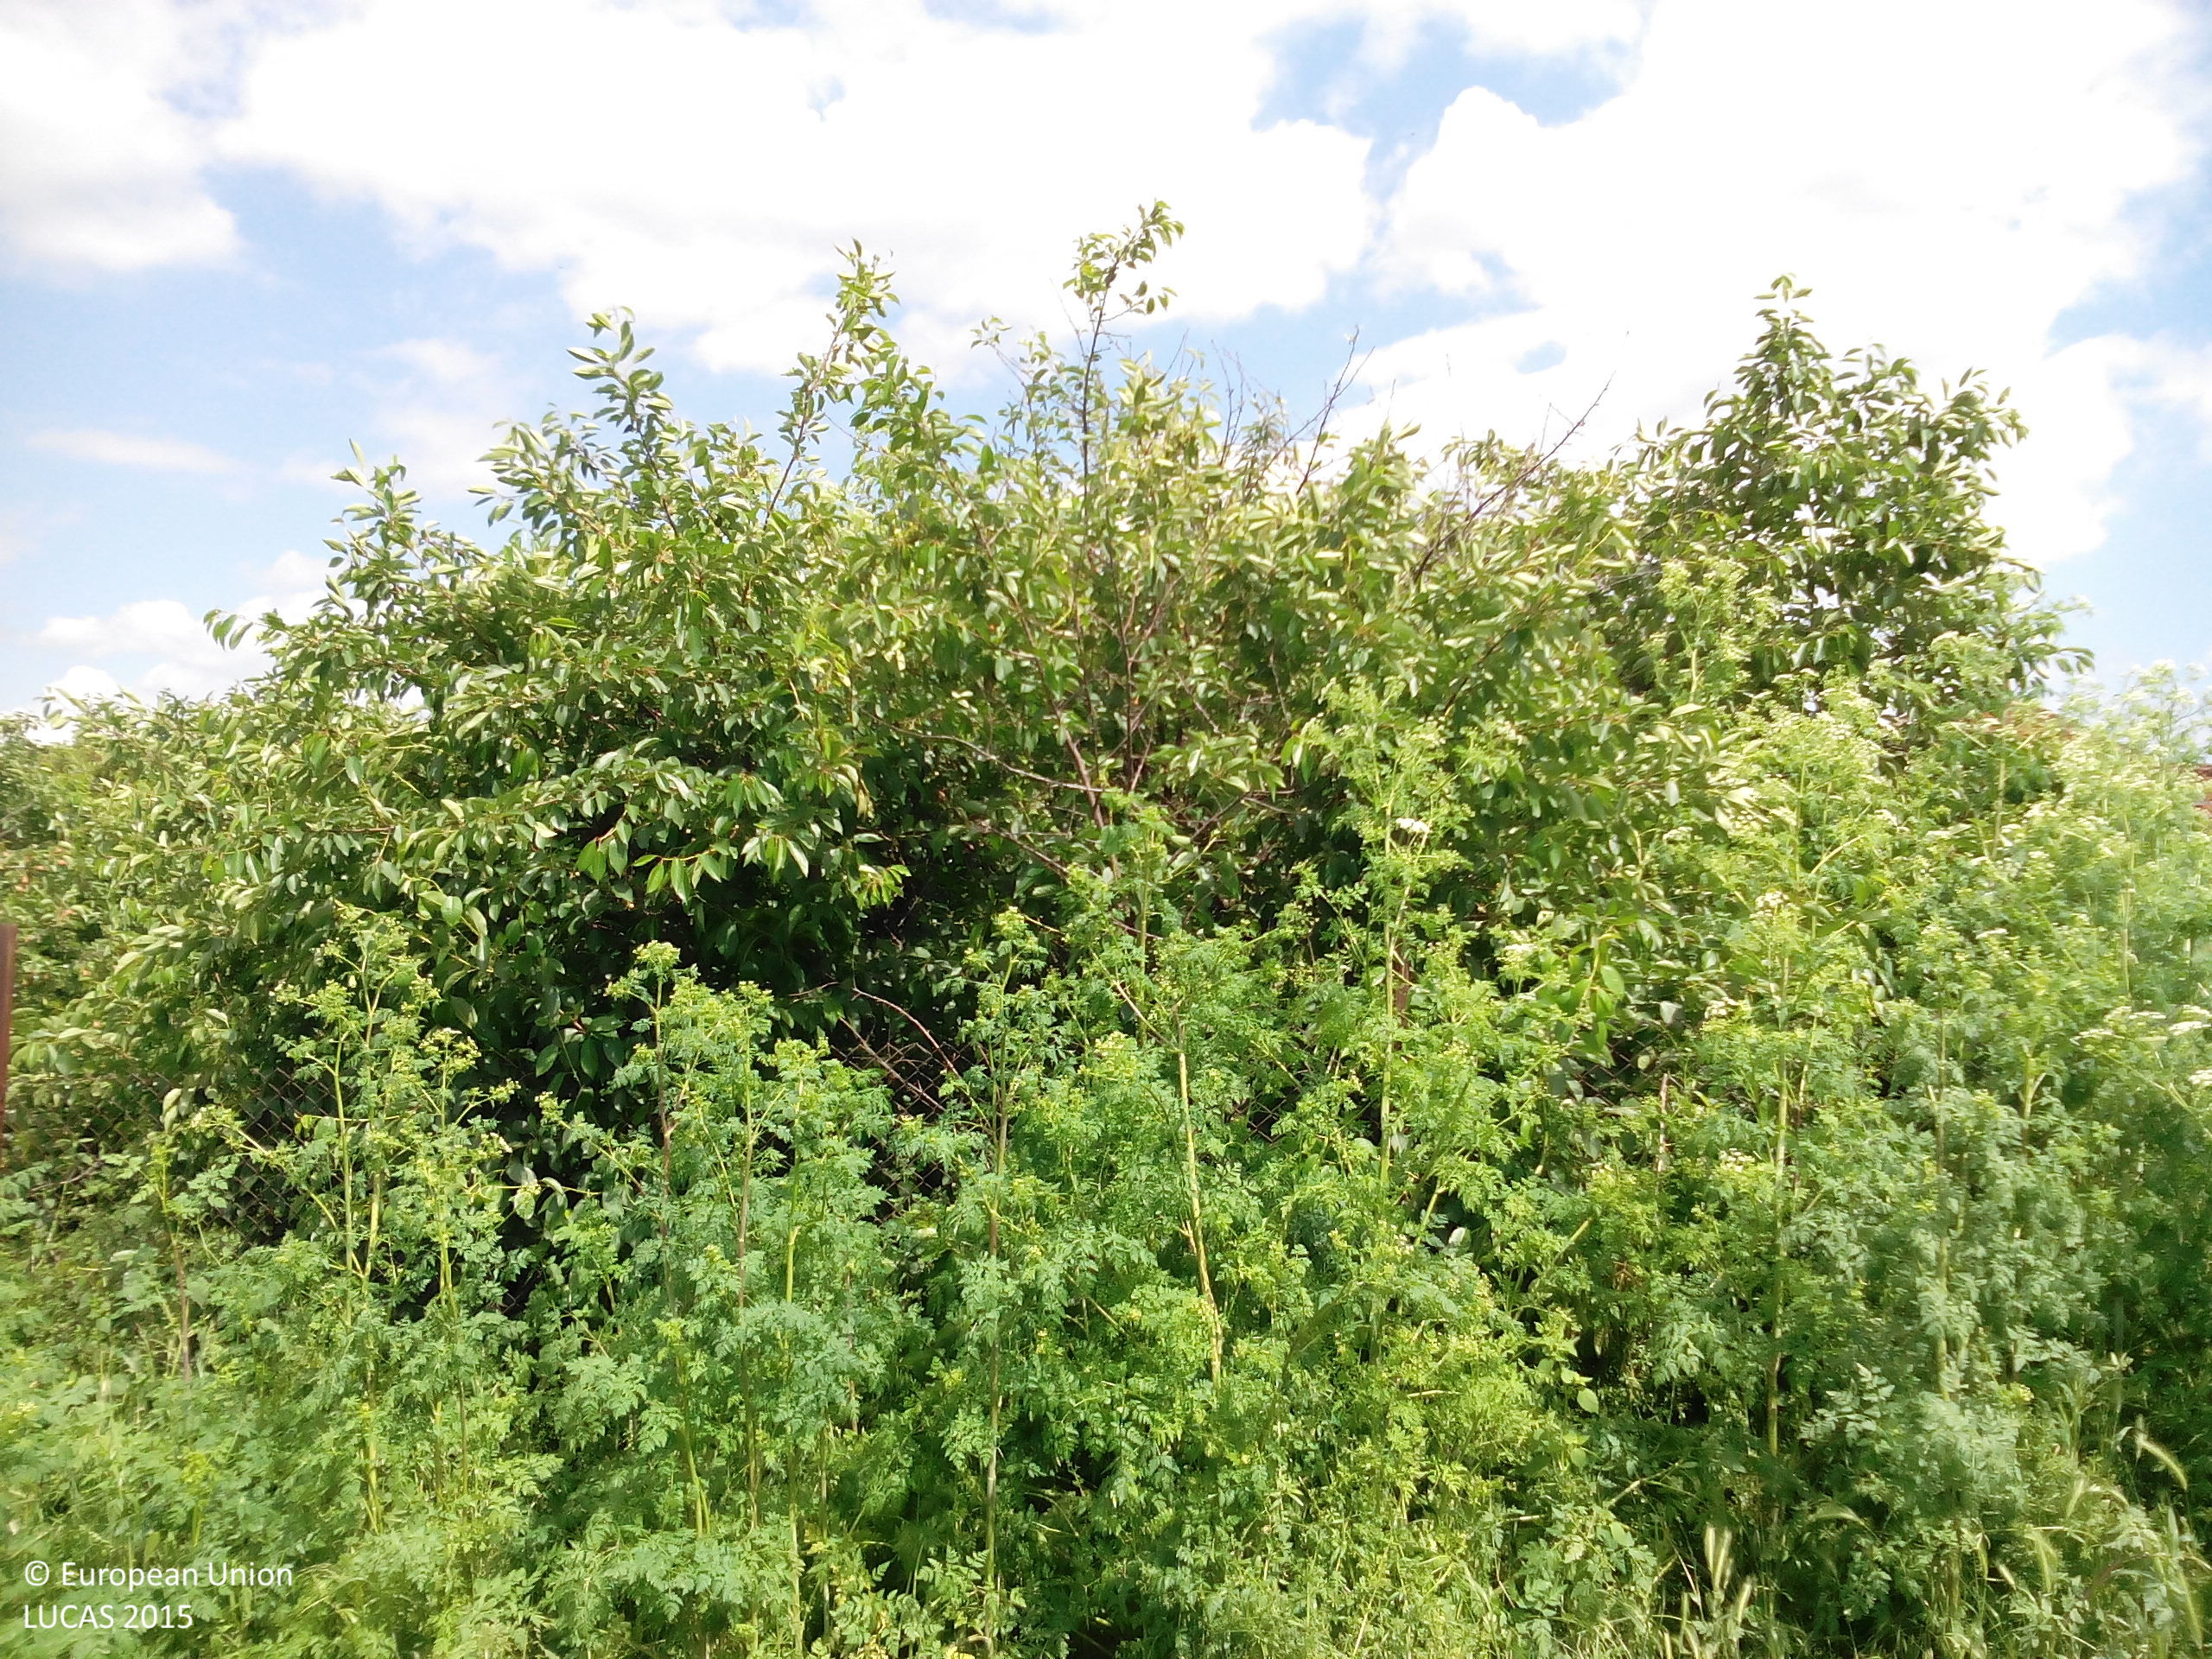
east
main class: Cropland
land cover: Cherry fruit
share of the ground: > 75 %
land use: Kitchen garden
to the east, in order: Cherry fruit; Spontaneously vegetated surfaces; Artificial constructions in urban areas
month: May
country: BG
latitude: 43.5058
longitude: 23.8664
